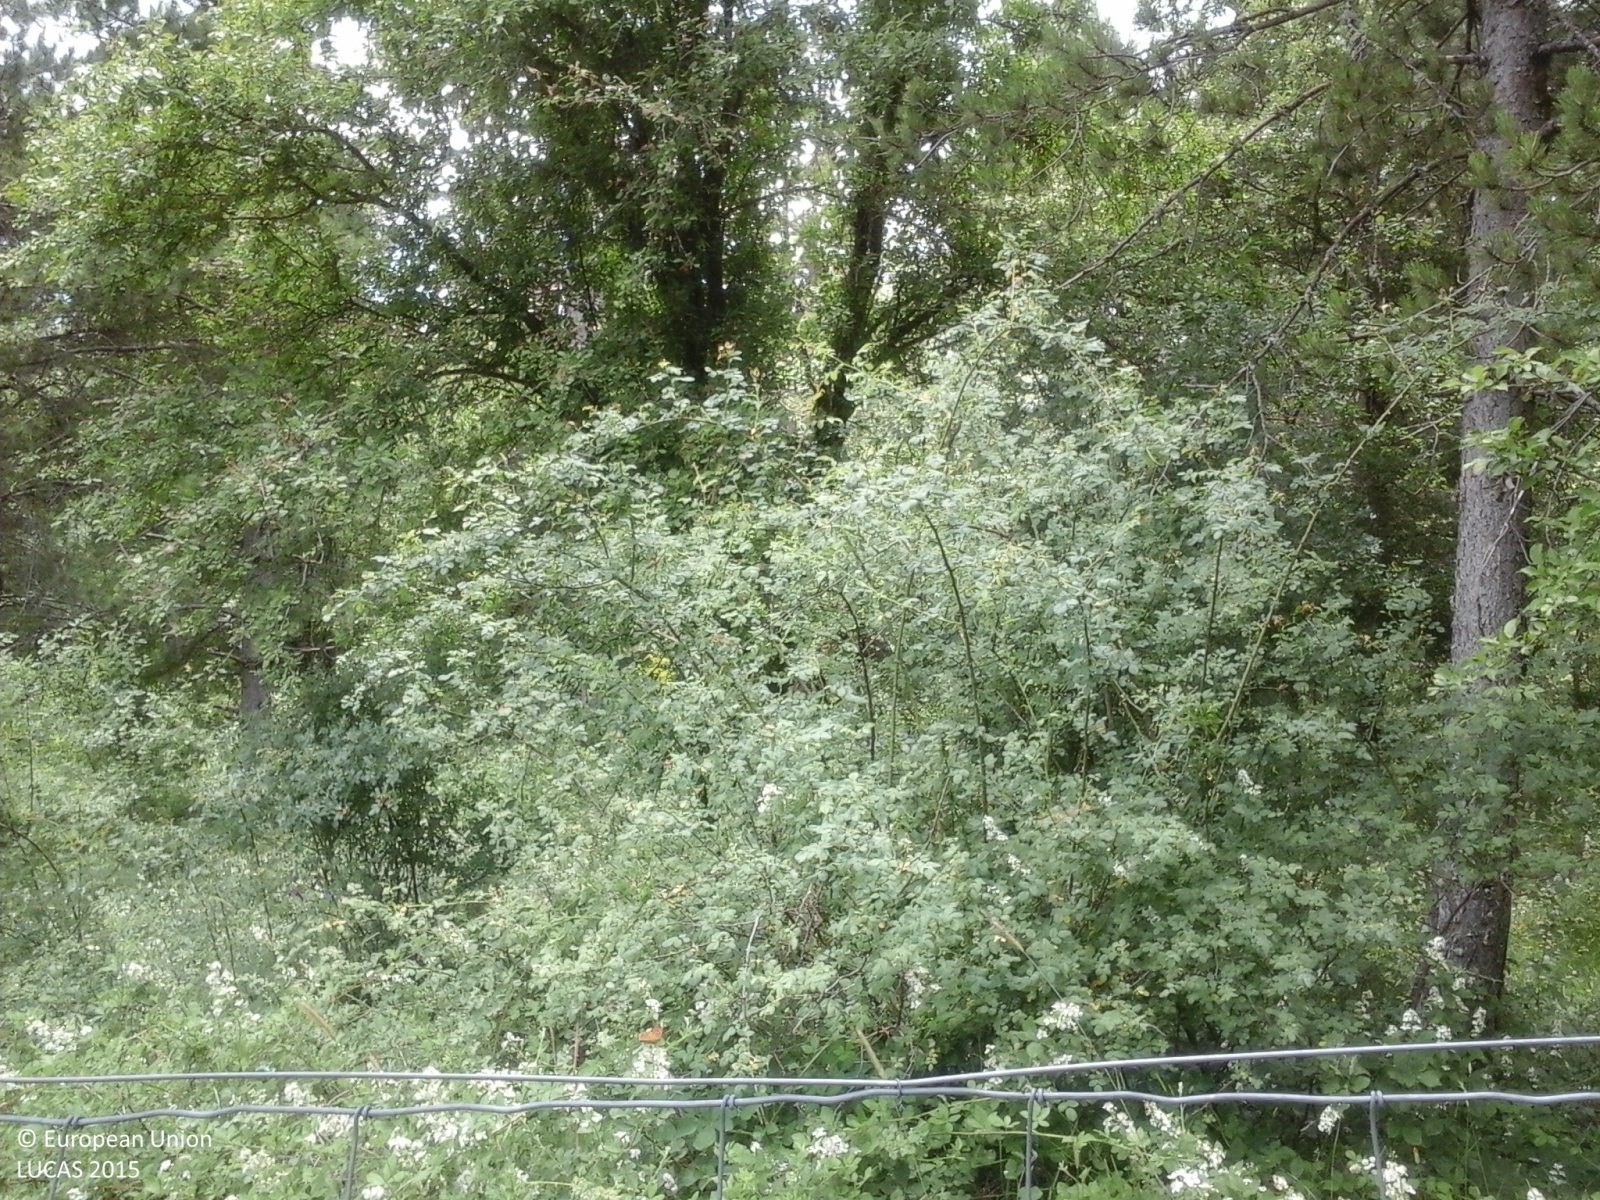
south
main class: Woodland
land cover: Broadleaved woodland
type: thermophilous deciduous forest
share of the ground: > 75 %
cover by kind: broadleaved forest trees 75 %, shrubs 15 %, herbaceous plants 10 %
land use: Amenities, museums, leisure
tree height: > 5 m
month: July
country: IT
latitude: 37.9329
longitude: 14.8481
